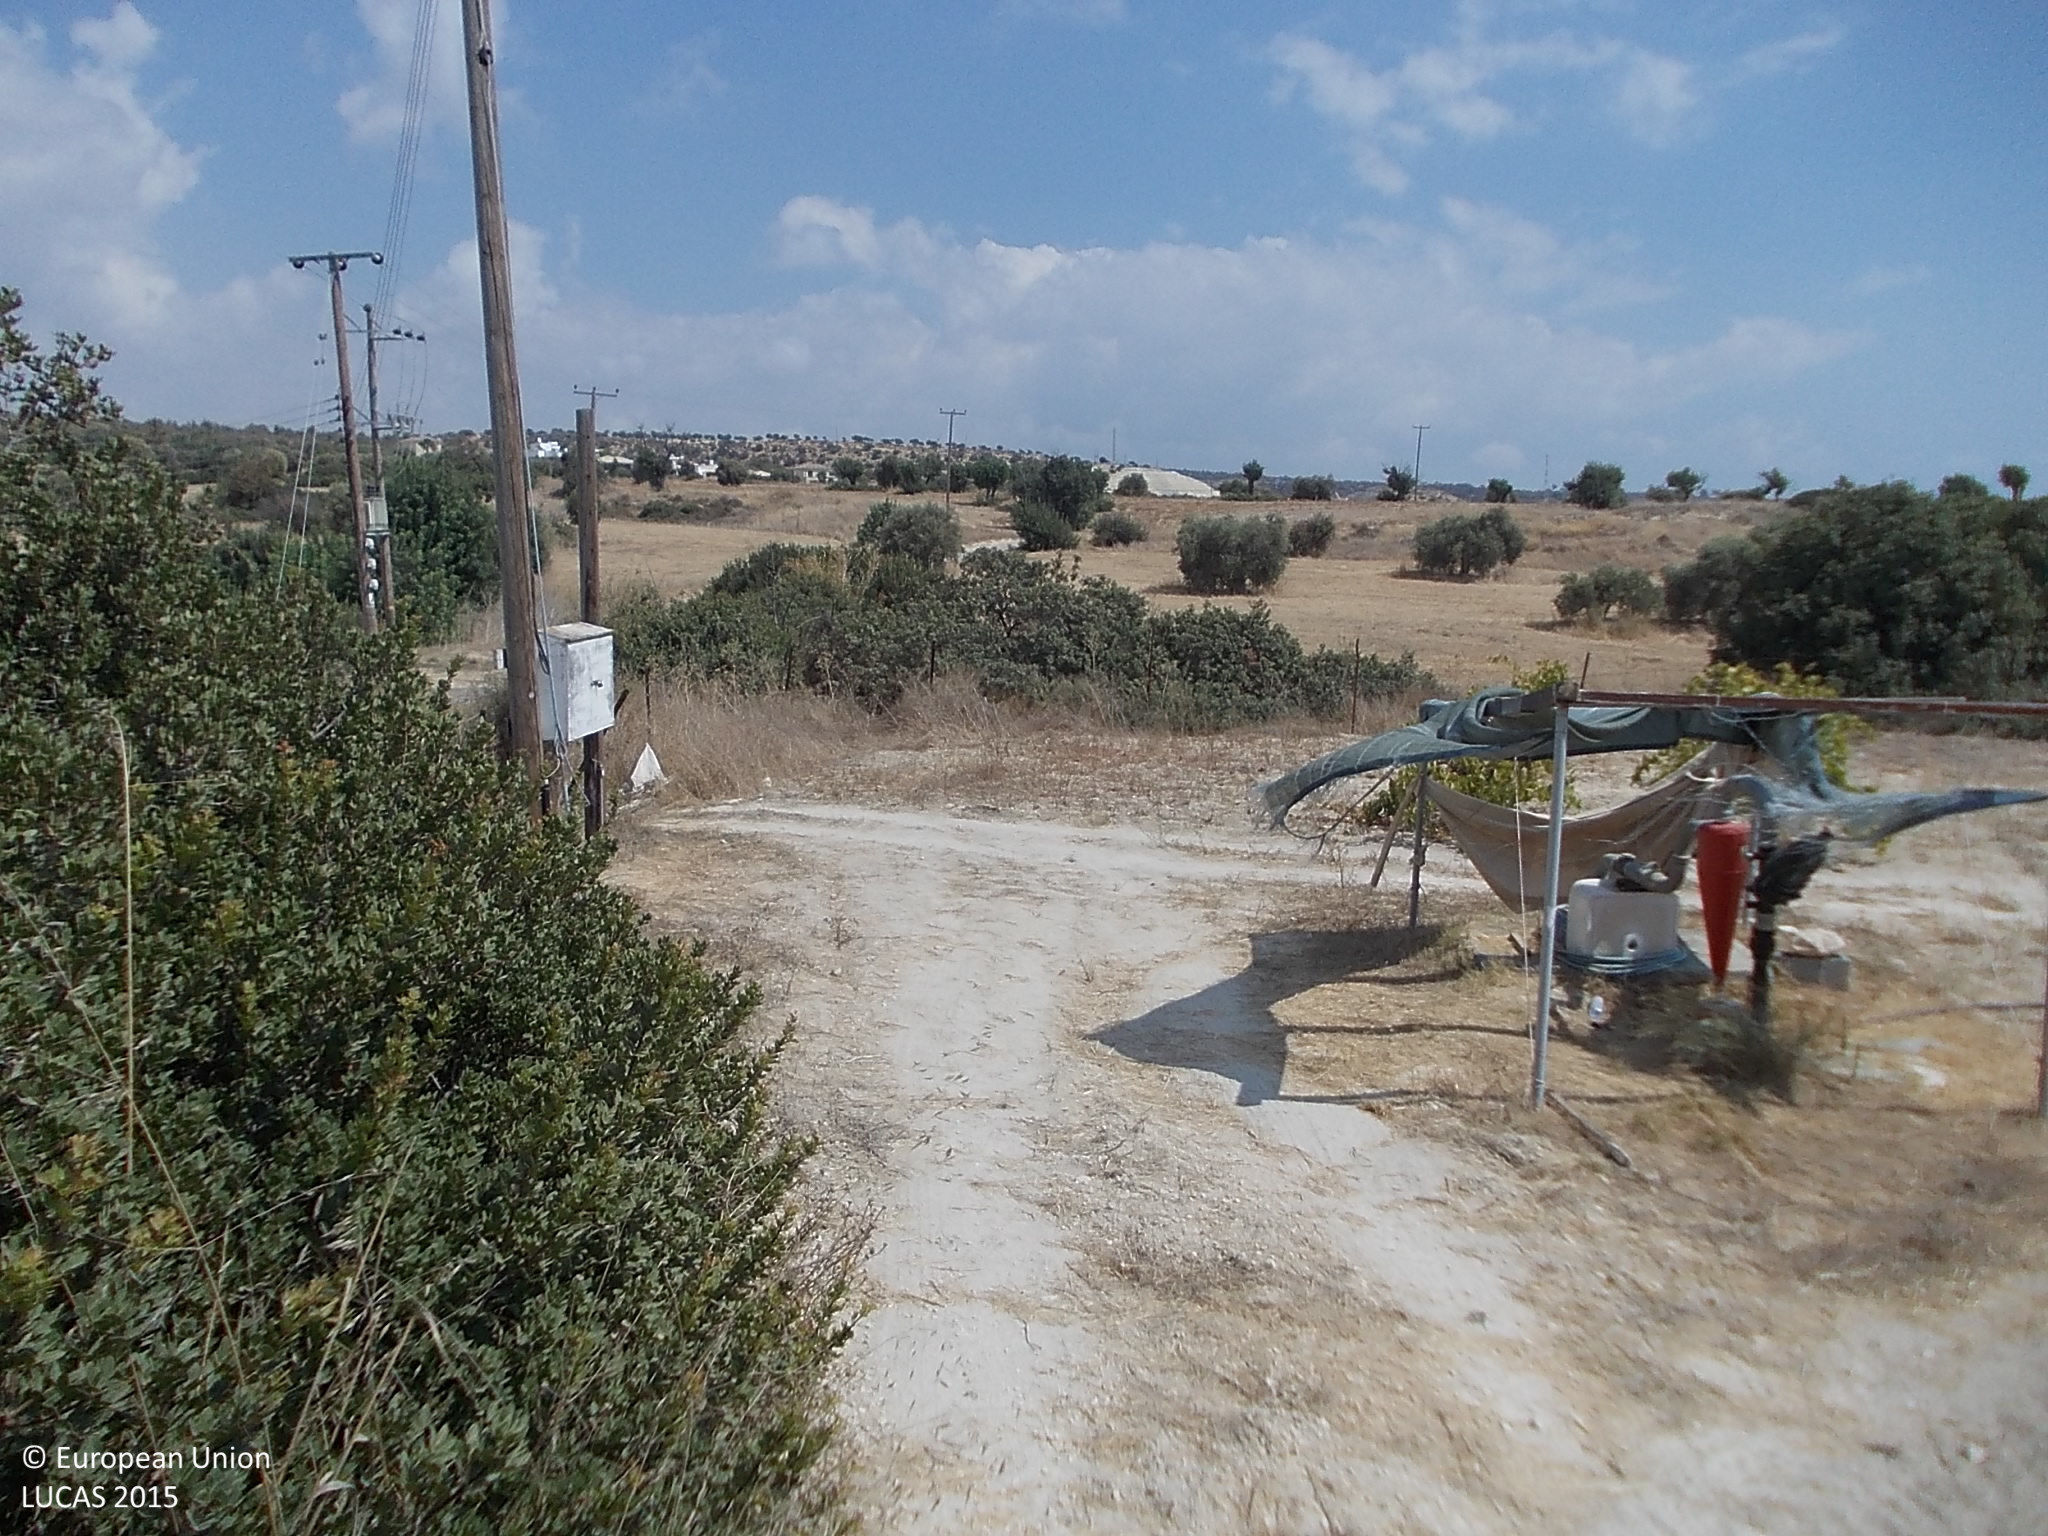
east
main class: Shrubland
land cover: Shrubland without tree cover
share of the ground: > 75 %
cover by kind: shrubs 95 %, herbaceous plants 5 %
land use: Semi-natural and natural areas not in use
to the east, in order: Other bare soil; Grassland without tree/shrub cover; Shrubland without tree cover; Other bare soil; Paved roads, cycling and walking lanes; Electric lines; Broadleaved woodland; Olive groves; Grassland with sparse tree/shrub cover
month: May
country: CY
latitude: 34.6811
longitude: 32.7807
